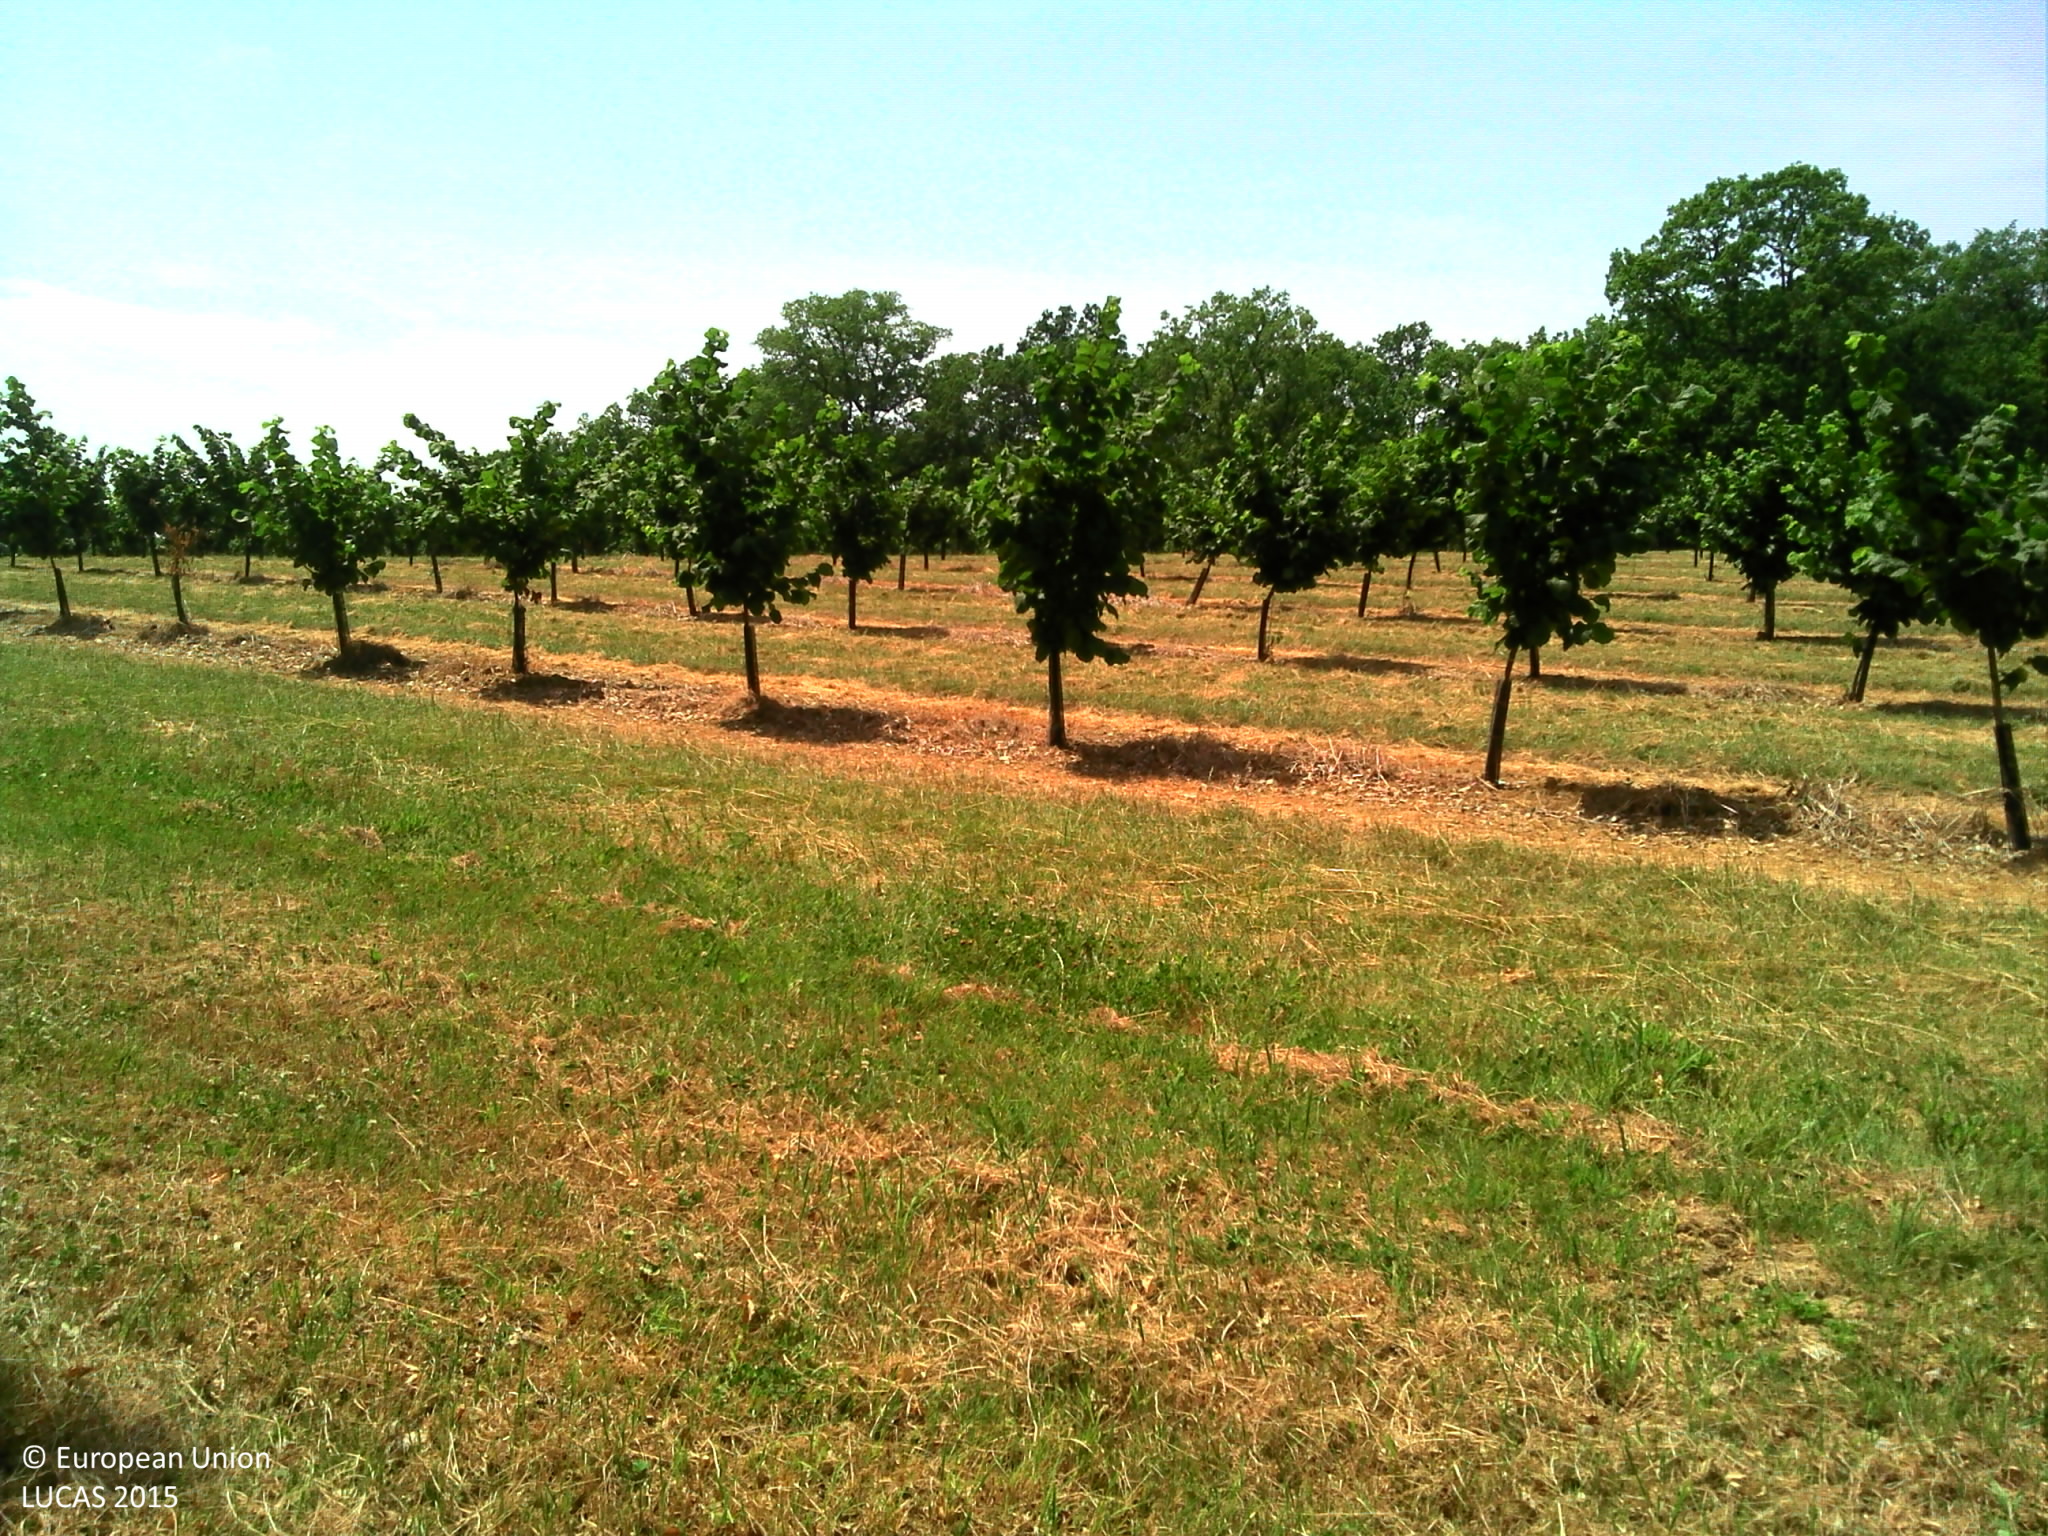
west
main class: Grassland
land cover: Grassland without tree/shrub cover
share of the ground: > 75 %
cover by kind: herbaceous plants 100 %
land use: Agriculture (excluding fallow land and kitchen gardens)
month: July
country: FR
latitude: 44.5079
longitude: 0.8498
